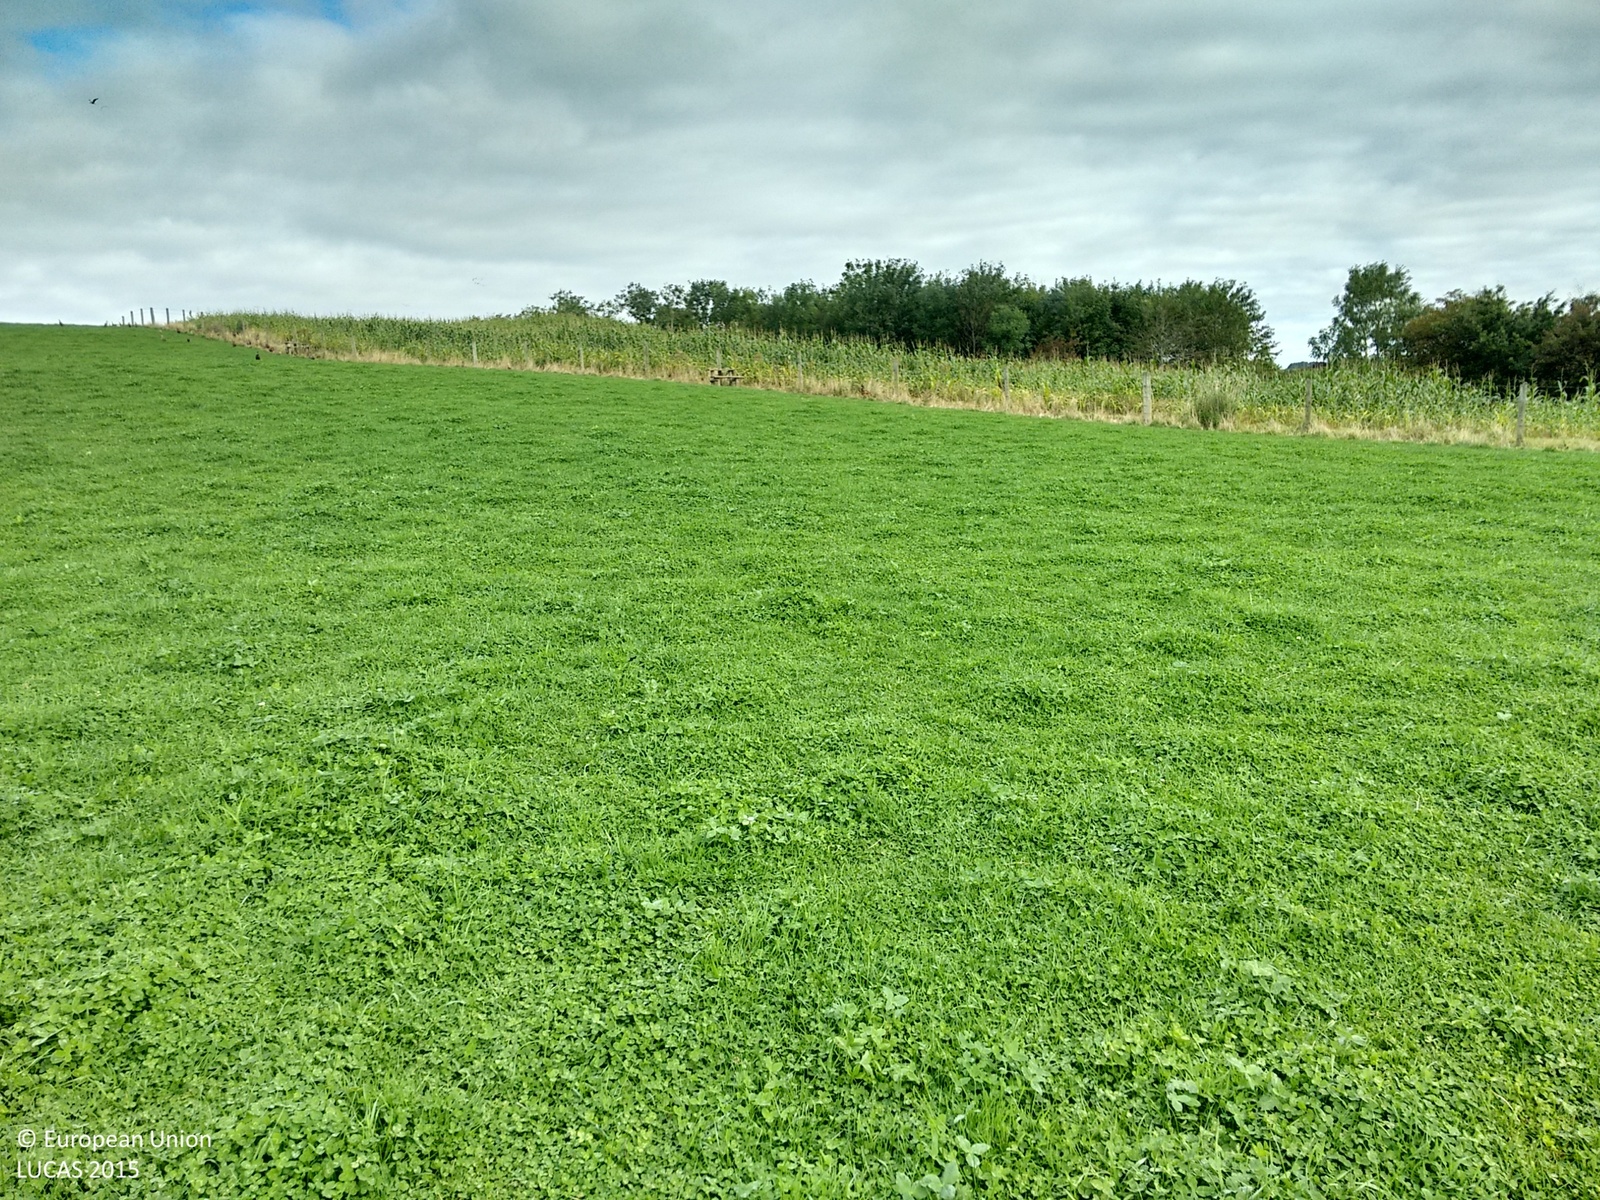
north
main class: Cropland
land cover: Other leguminous and mixtures for fodder
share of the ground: > 75 %
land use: Agriculture (excluding fallow land and kitchen gardens)
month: September
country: GB
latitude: 50.6381
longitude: -4.2241
